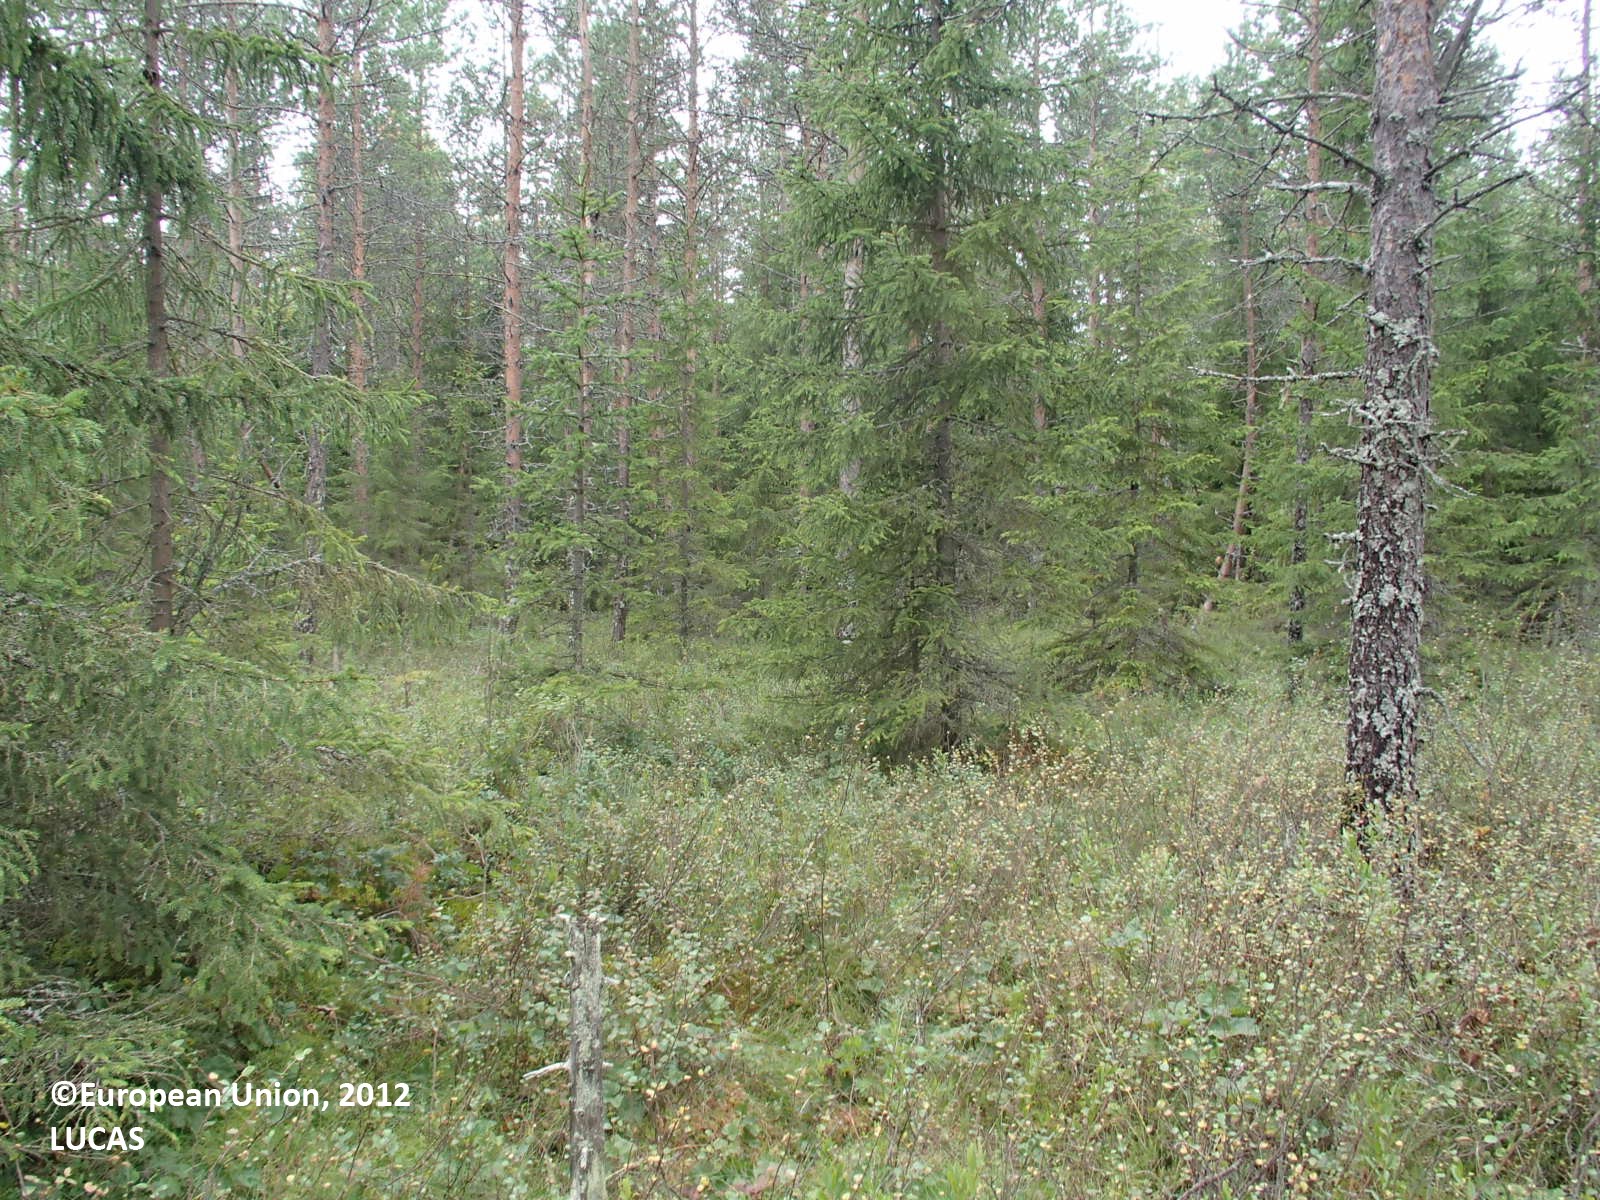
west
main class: Woodland
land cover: Other coniferous woodland
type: boreal forest
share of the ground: > 75 %
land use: Forestry
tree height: > 5 m
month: August
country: FI
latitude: 63.6314
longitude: 27.8642
